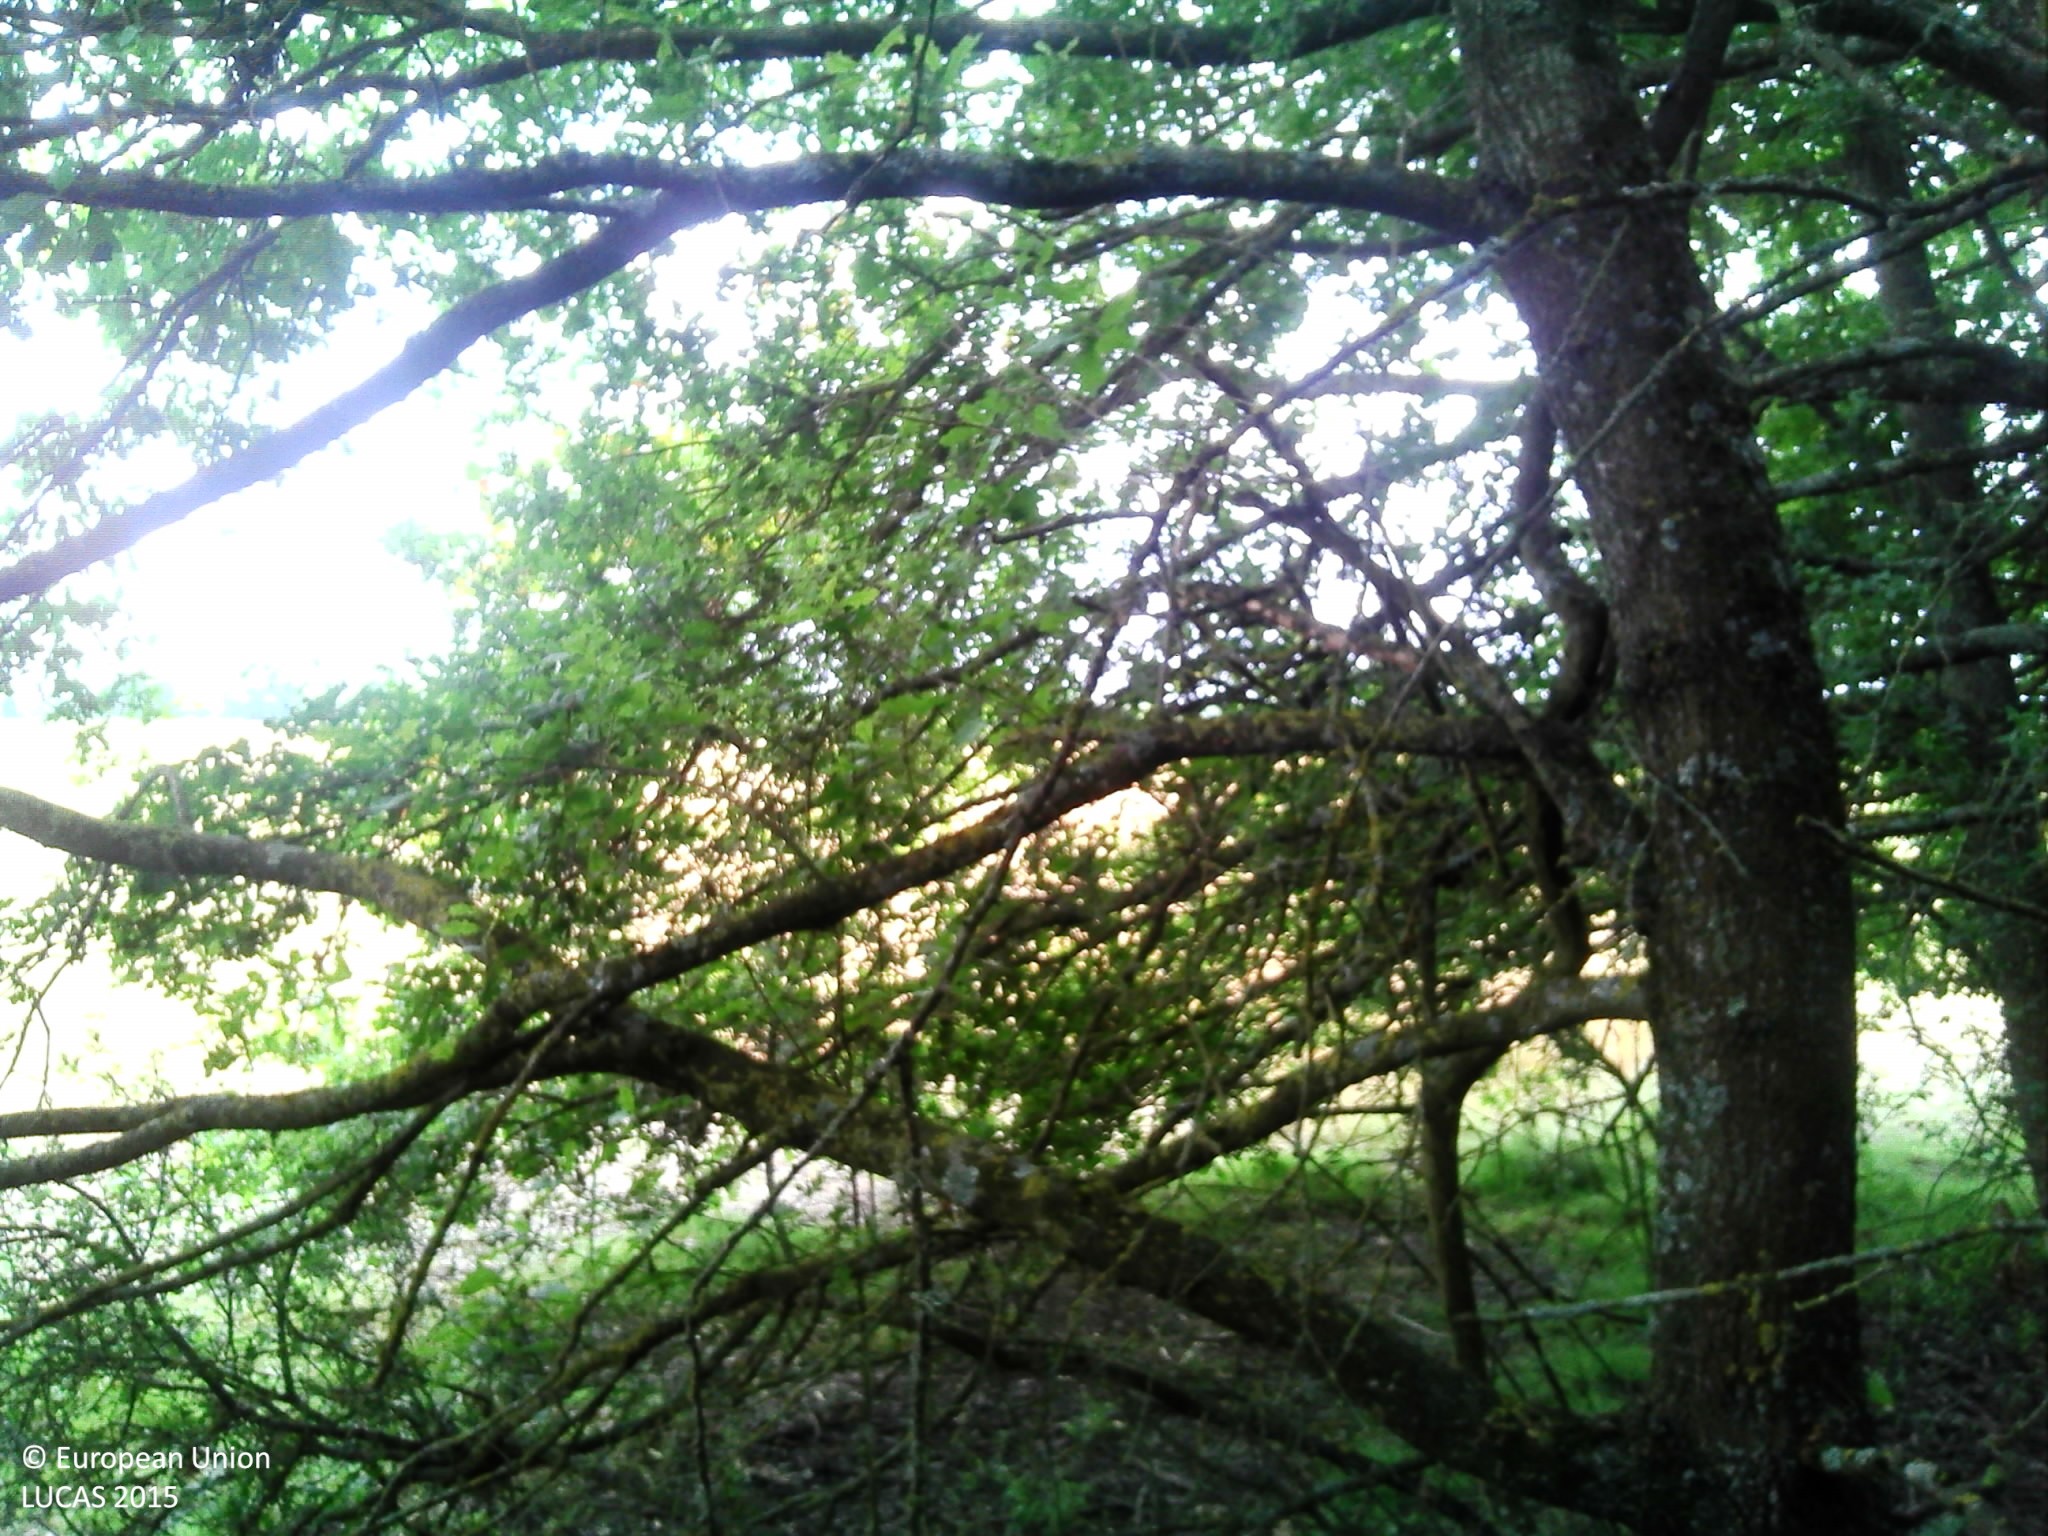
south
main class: Woodland
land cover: Broadleaved woodland
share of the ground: > 75 %
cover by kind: broadleaved forest trees 100 %
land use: Agriculture (excluding fallow land and kitchen gardens)
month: June
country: FR
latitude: 47.6102
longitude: 2.5555
